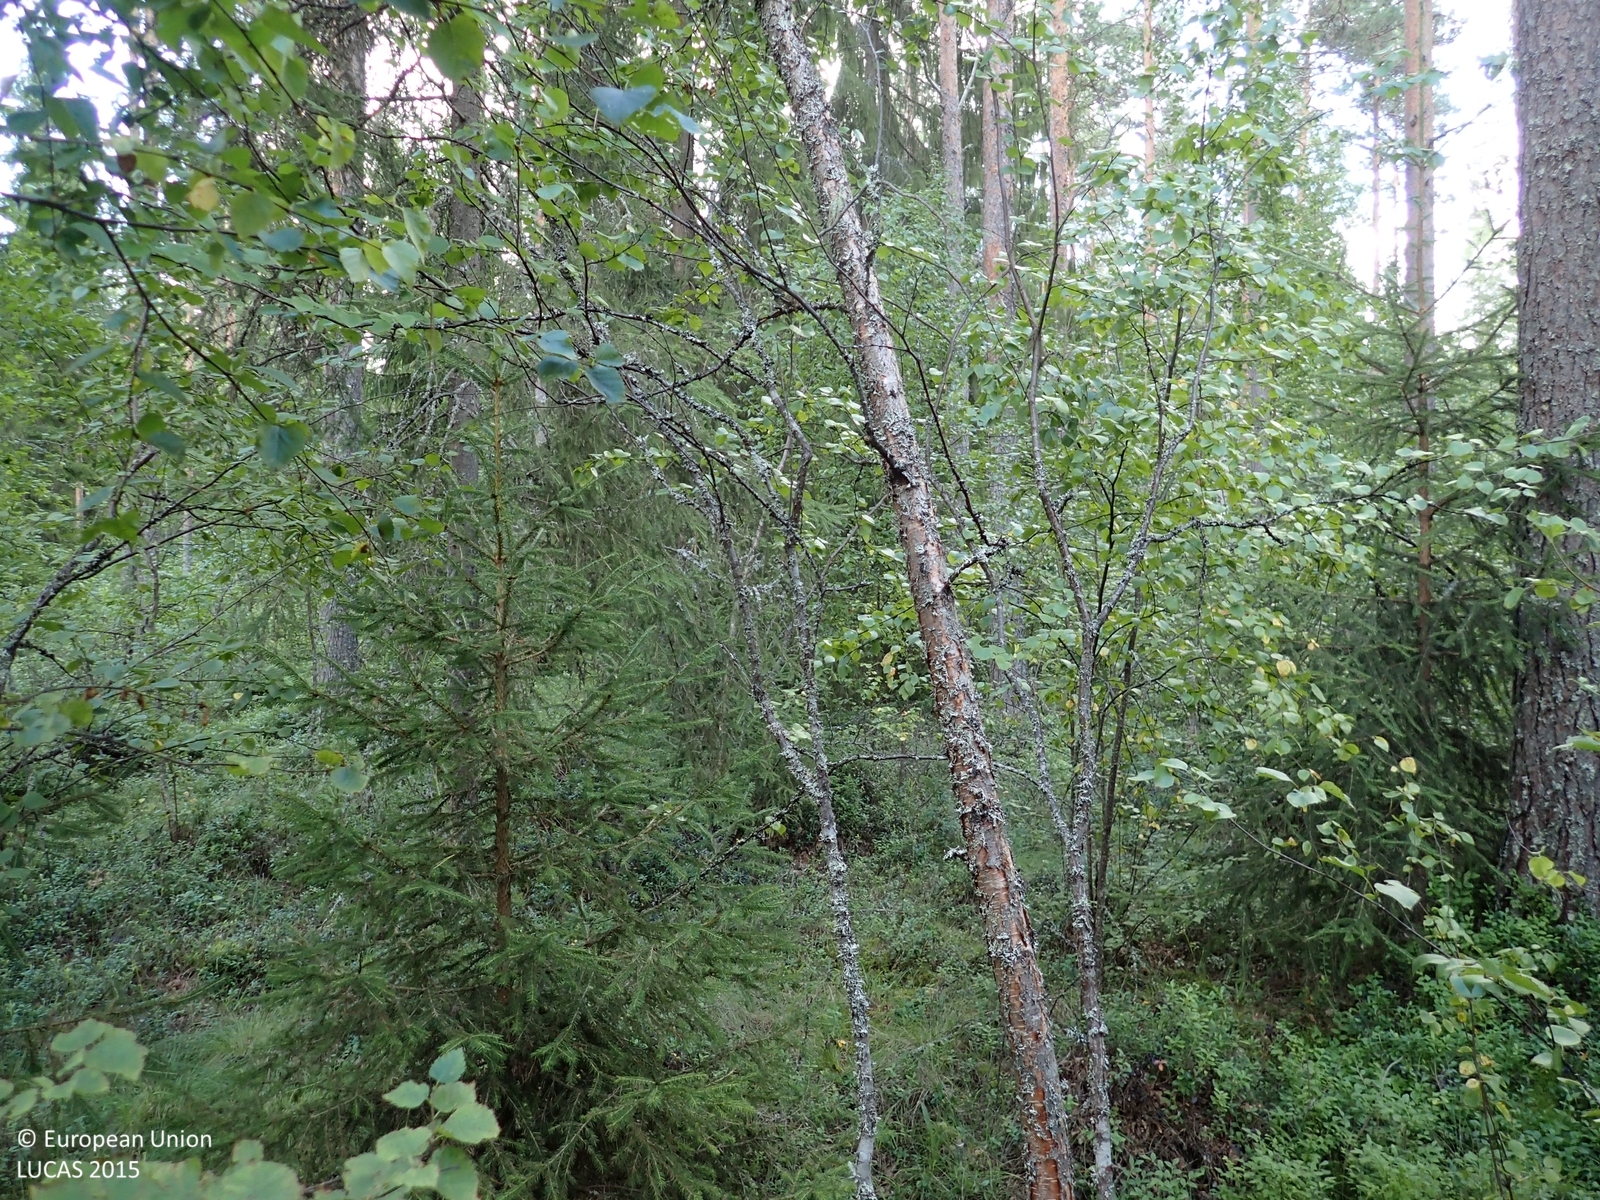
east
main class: Woodland
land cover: Pine dominated mixed woodland
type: boreal forest
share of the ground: > 75 %
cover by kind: coniferous forest trees 60 %, broadleaved forest trees 20 %, shrubs 15 %, herbaceous plants 5 %
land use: Forestry
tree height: > 5 m
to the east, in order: Pine dominated mixed woodland; Other mixed woodland; Grass margins; Paved roads, cycling and walking lanes; Grass margins; Other mixed woodland; Tracks; Broadleaved woodland; Inland fresh running water; Grassland with sparse tree/shrub cover; Spruce dominated mixed woodland; Tracks; Other mixed woodland
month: August
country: FI
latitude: 62.7513
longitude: 22.0091
